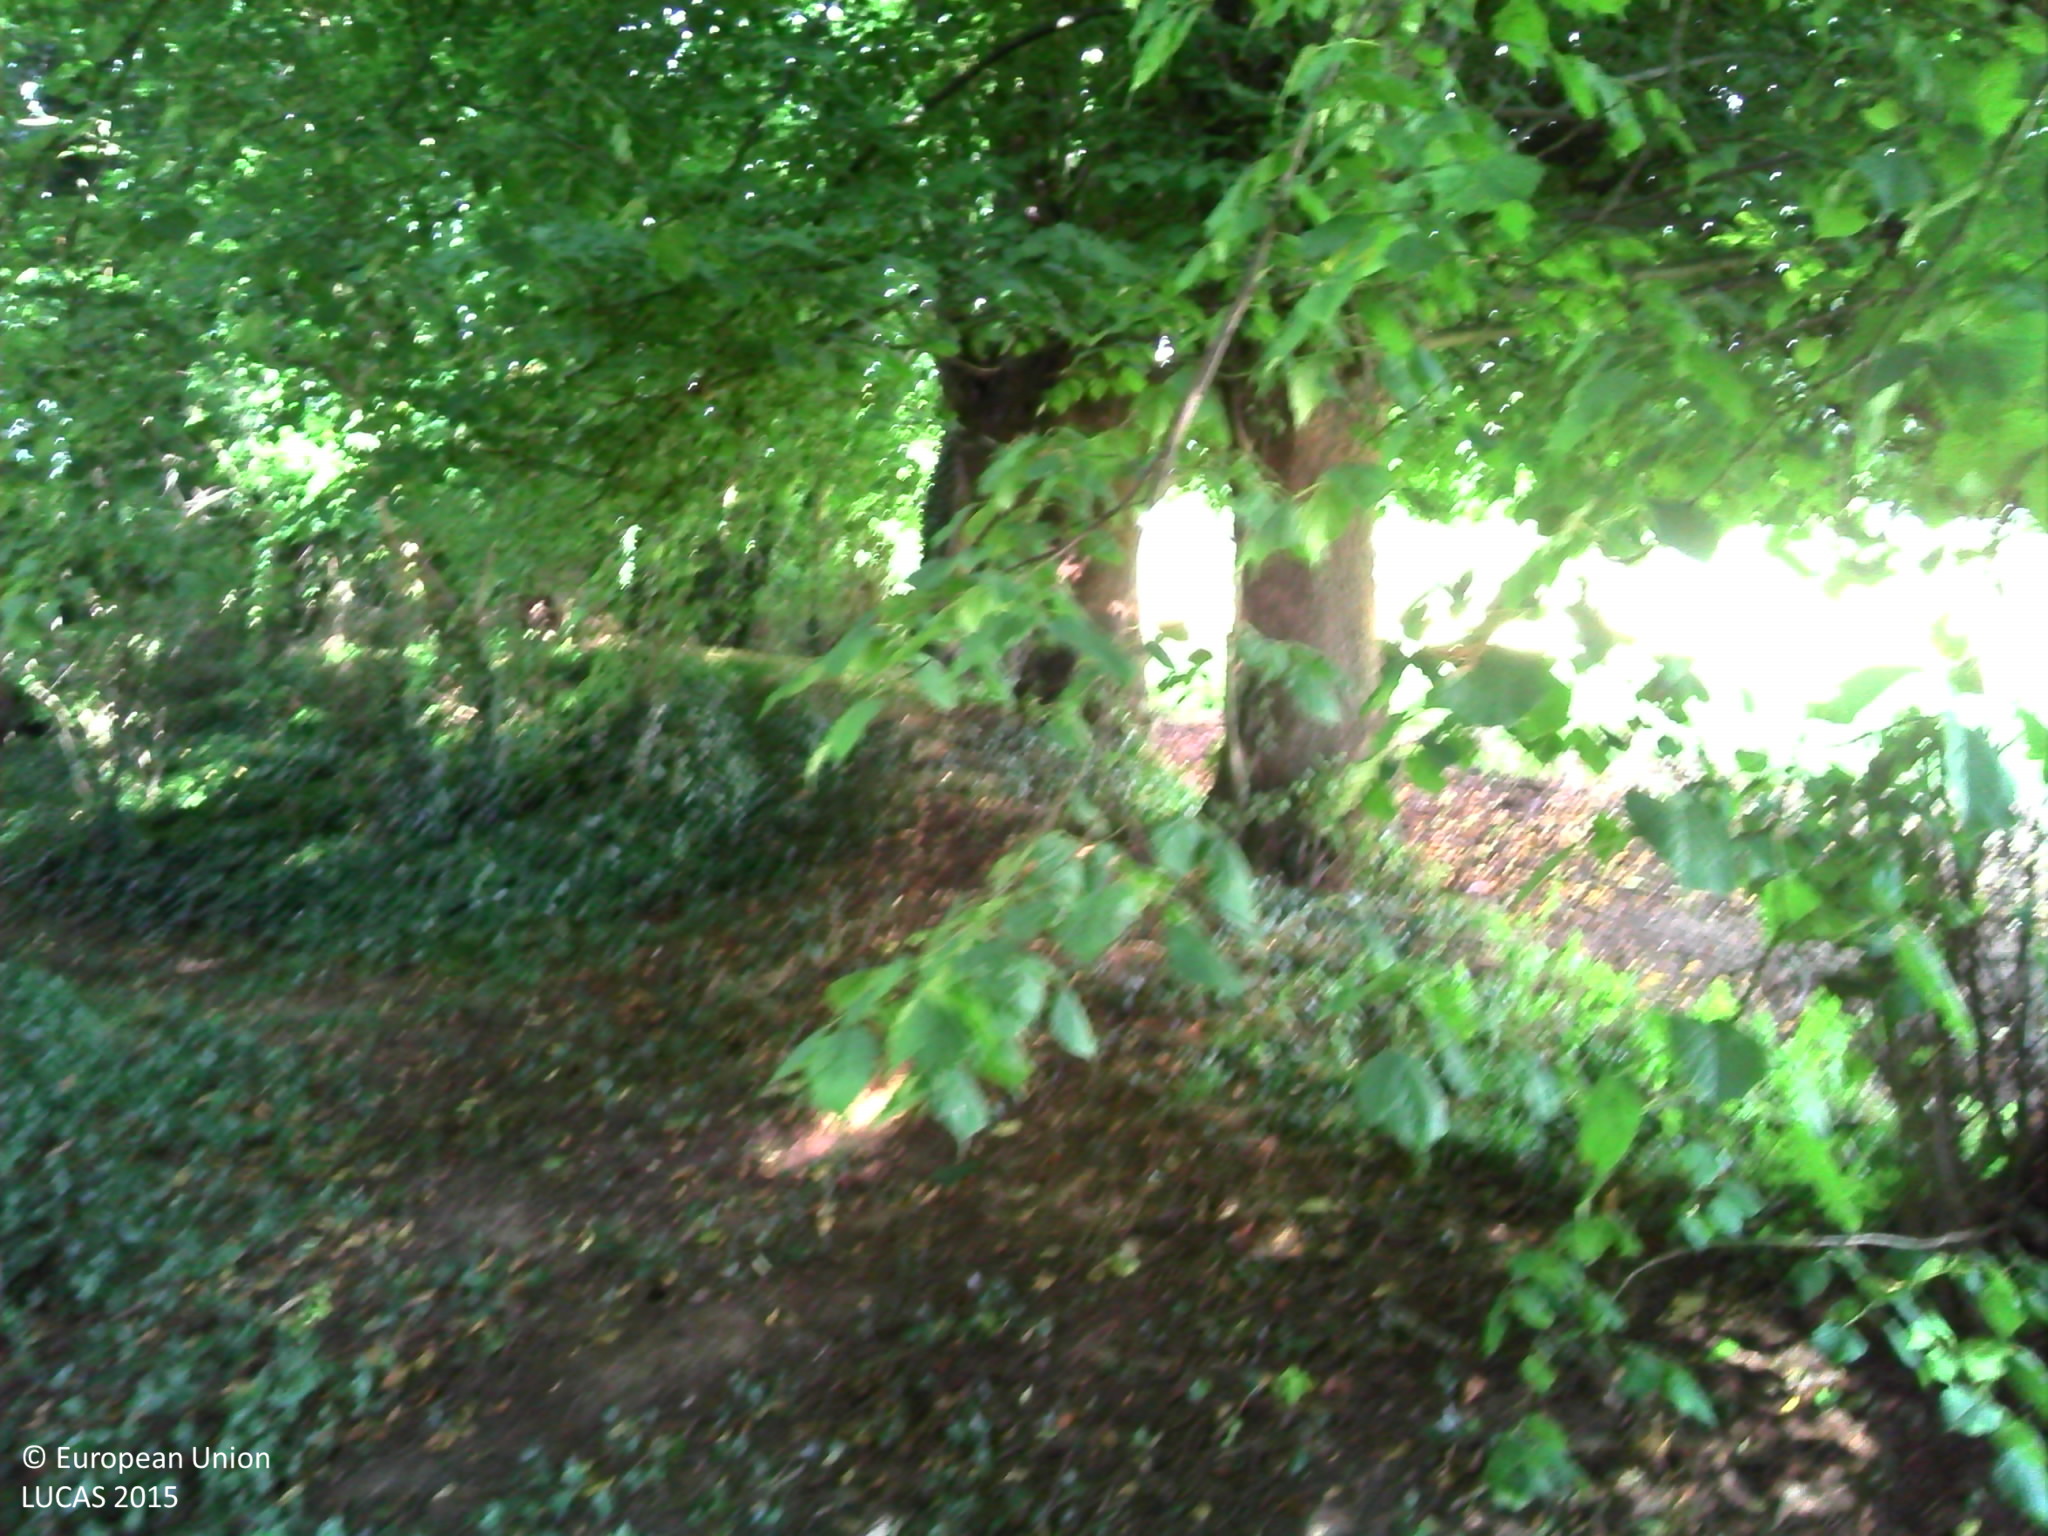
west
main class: Woodland
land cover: Broadleaved woodland
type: mesophytic deciduous forest
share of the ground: > 75 %
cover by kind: broadleaved forest trees 90 %, shrubs 5 %, herbaceous plants 5 %
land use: Forestry
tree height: > 5 m
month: July
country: FR
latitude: 49.0829
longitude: -0.2889
